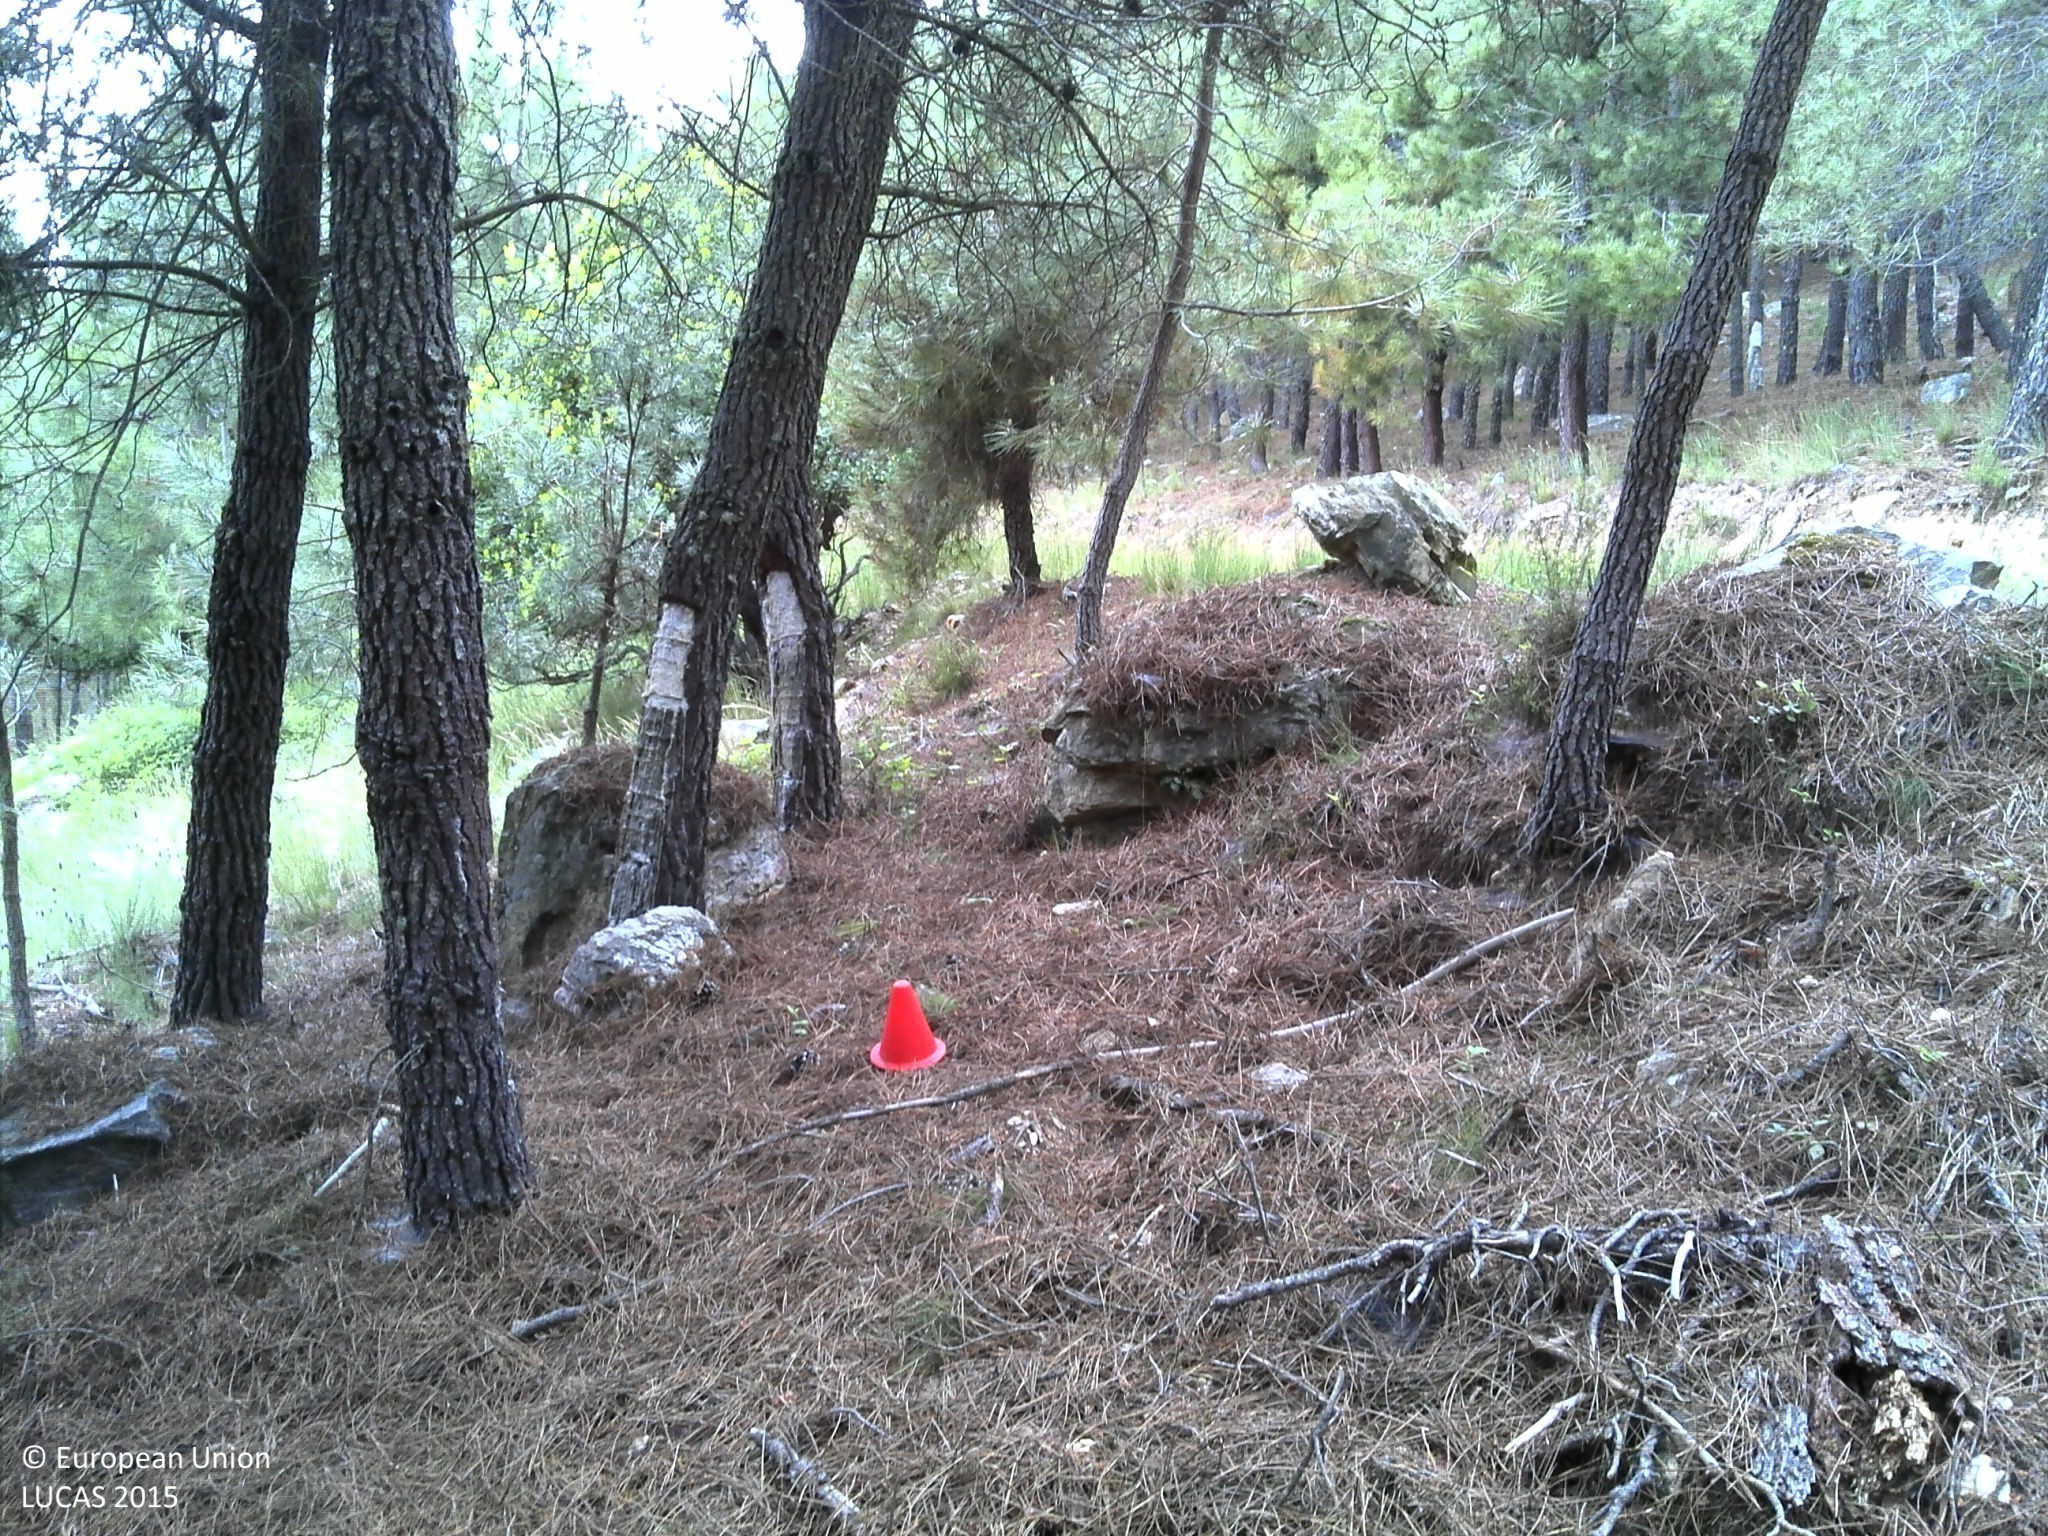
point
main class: Woodland
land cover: Pine dominated coniferous woodland
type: coniferous forest of the mediterranean region
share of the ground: 50 - 75 %
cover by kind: coniferous forest trees 75 %, unconsolidated bare surface 25 %
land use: Forestry
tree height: > 5 m
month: May
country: PT
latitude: 41.7461
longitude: -7.0632
